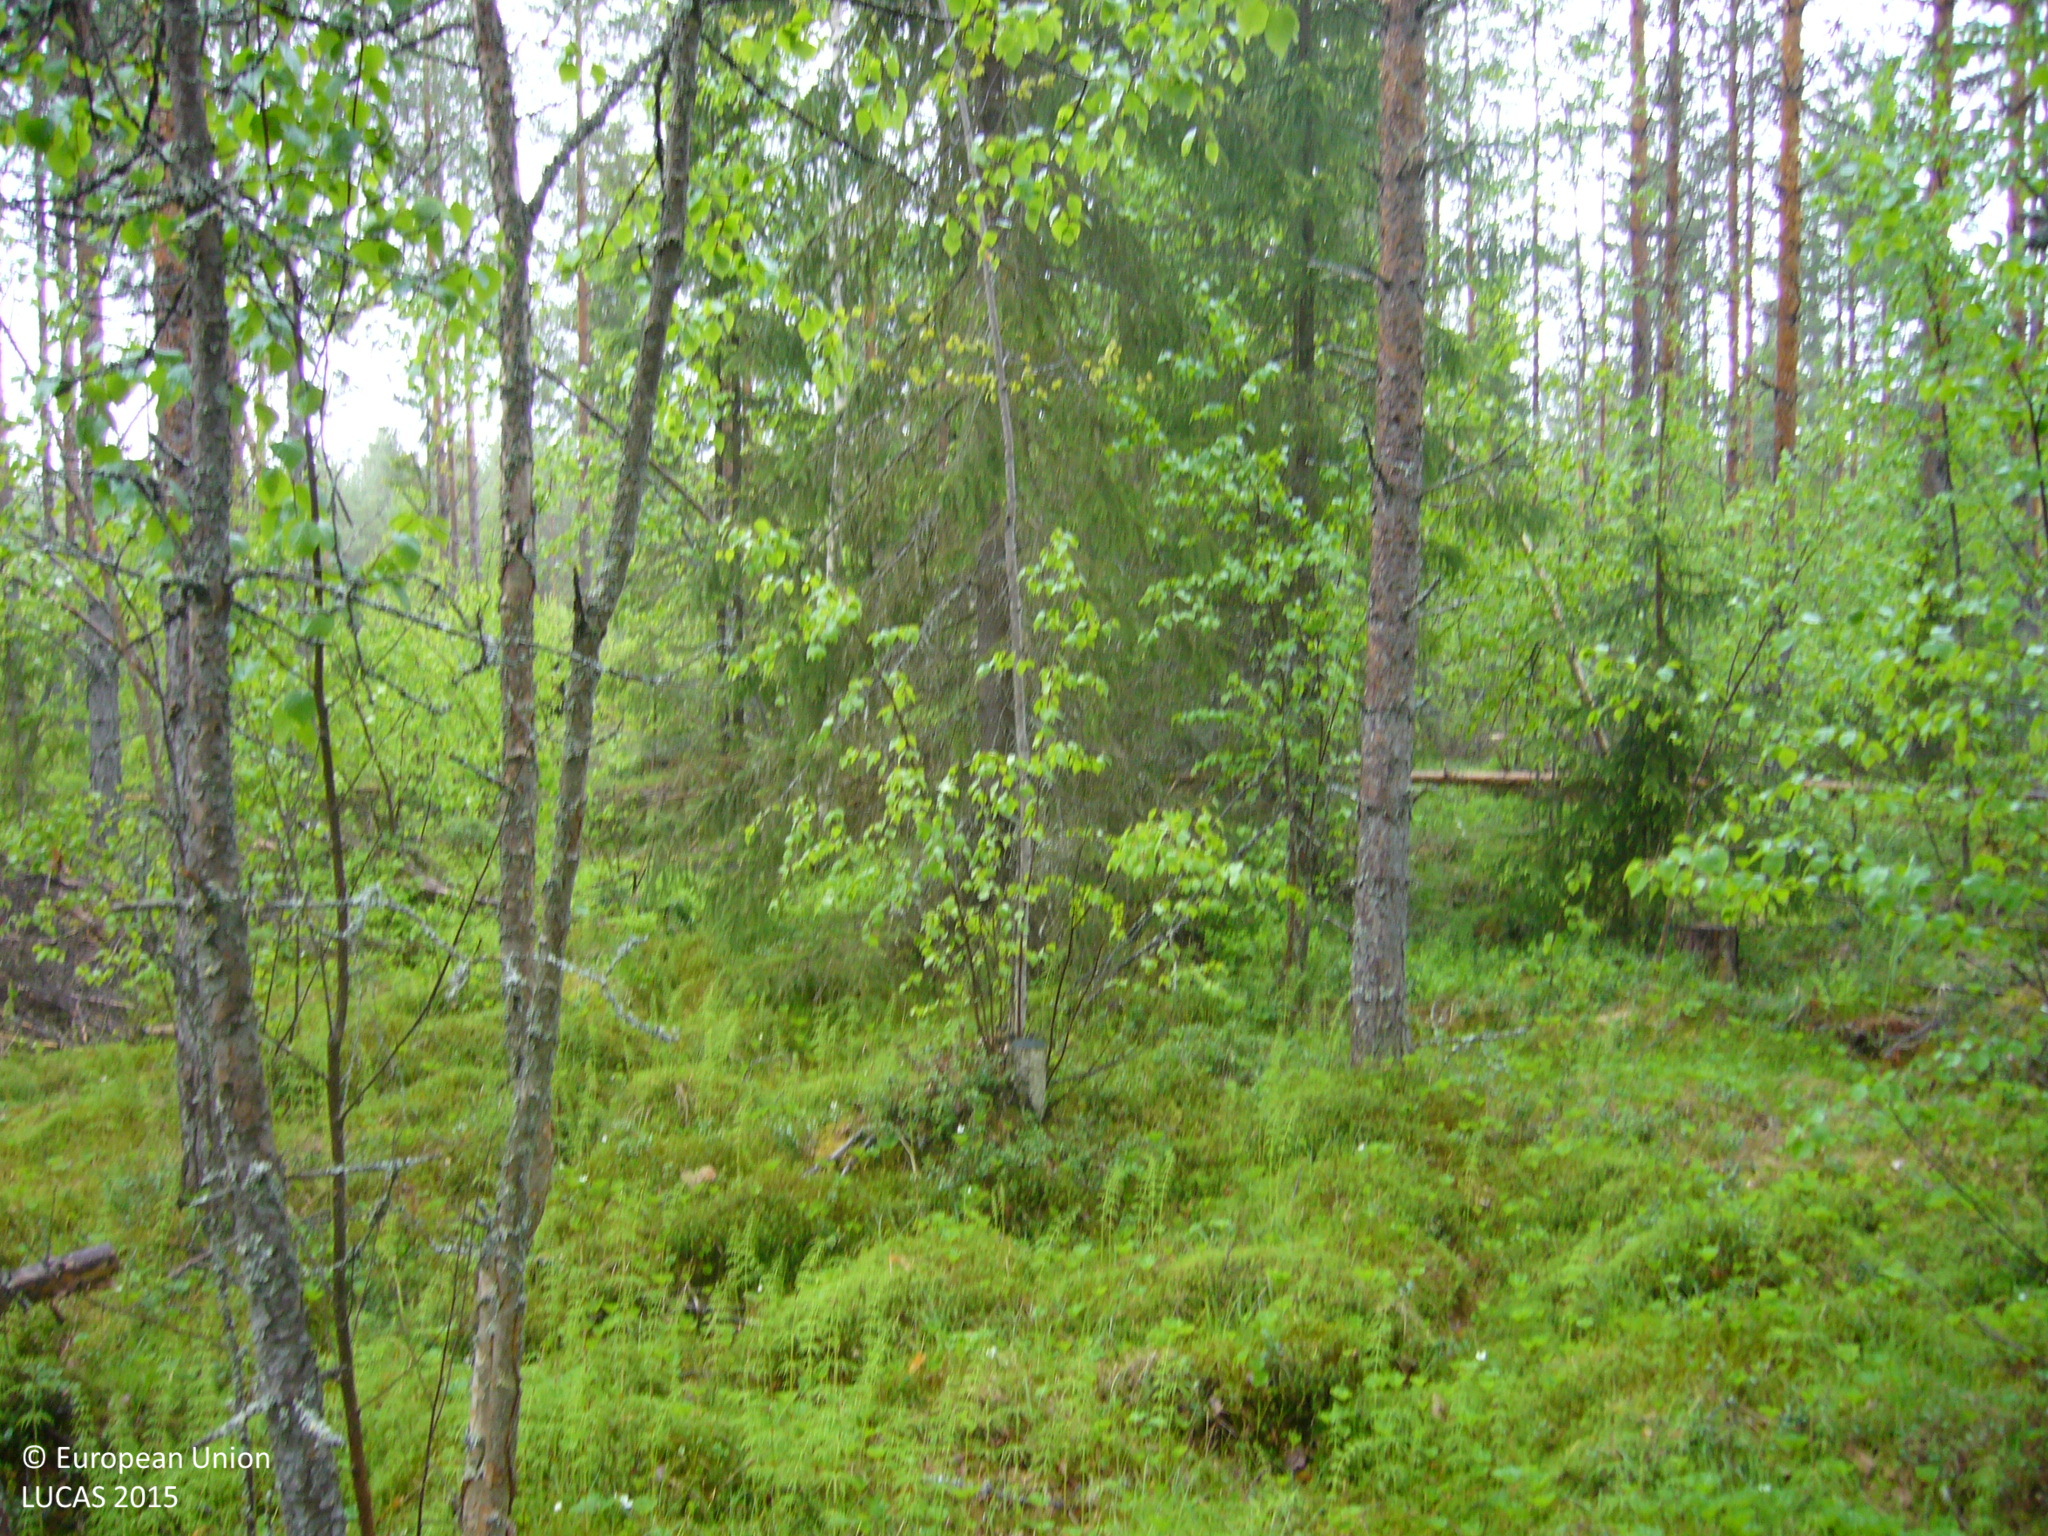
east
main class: Woodland
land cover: Pine dominated mixed woodland
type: boreal forest
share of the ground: 50 - 75 %
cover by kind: broadleaved forest trees 40 %, coniferous forest trees 30 %, shrubs 30 %
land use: Forestry
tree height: > 5 m
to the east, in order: Pine dominated mixed woodland; Ditches and canals; Grass margins; Paved roads, cycling and walking lanes; Grass margins; Ditches and canals; Shrubland with sparse tree cover; Ditches and canals; Shrubland with sparse tree cover; Pine dominated mixed woodland; Other bare soil; Ditches and canals; Other bare soil; Ditches and canals; Other bare soil
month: June
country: FI
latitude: 63.2704
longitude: 26.2851
